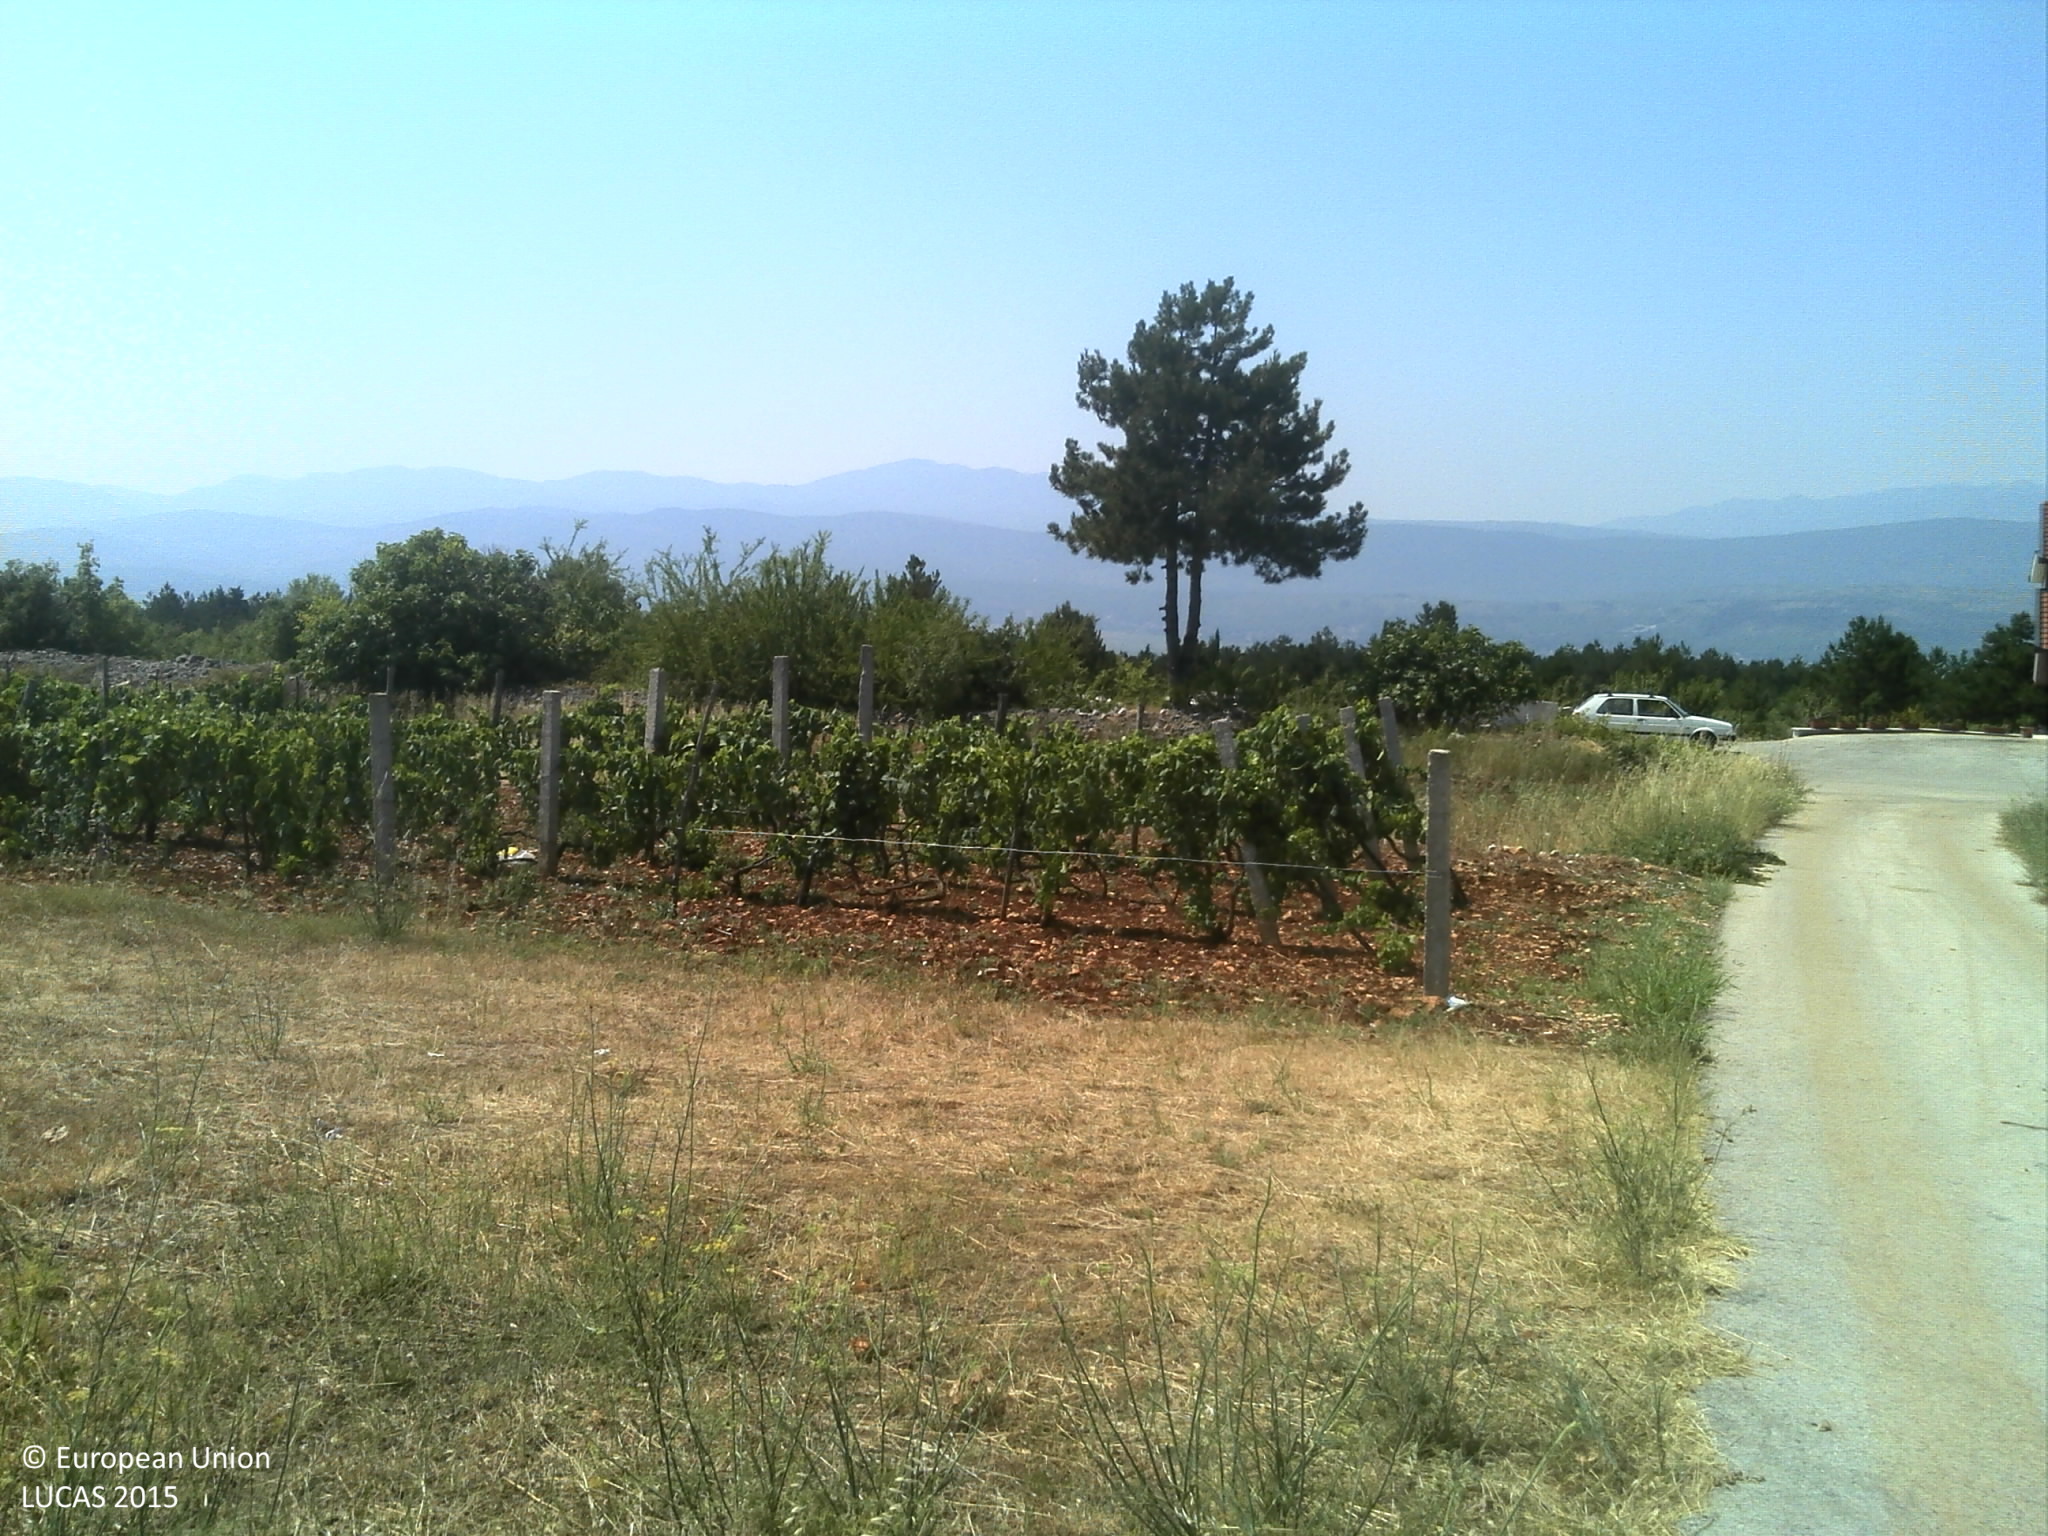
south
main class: Cropland
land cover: Vineyards
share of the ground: > 75 %
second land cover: Other bare soil
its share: > 75 %
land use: Agriculture (excluding fallow land and kitchen gardens)
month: July
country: HR
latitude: 43.4435
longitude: 17.2697
